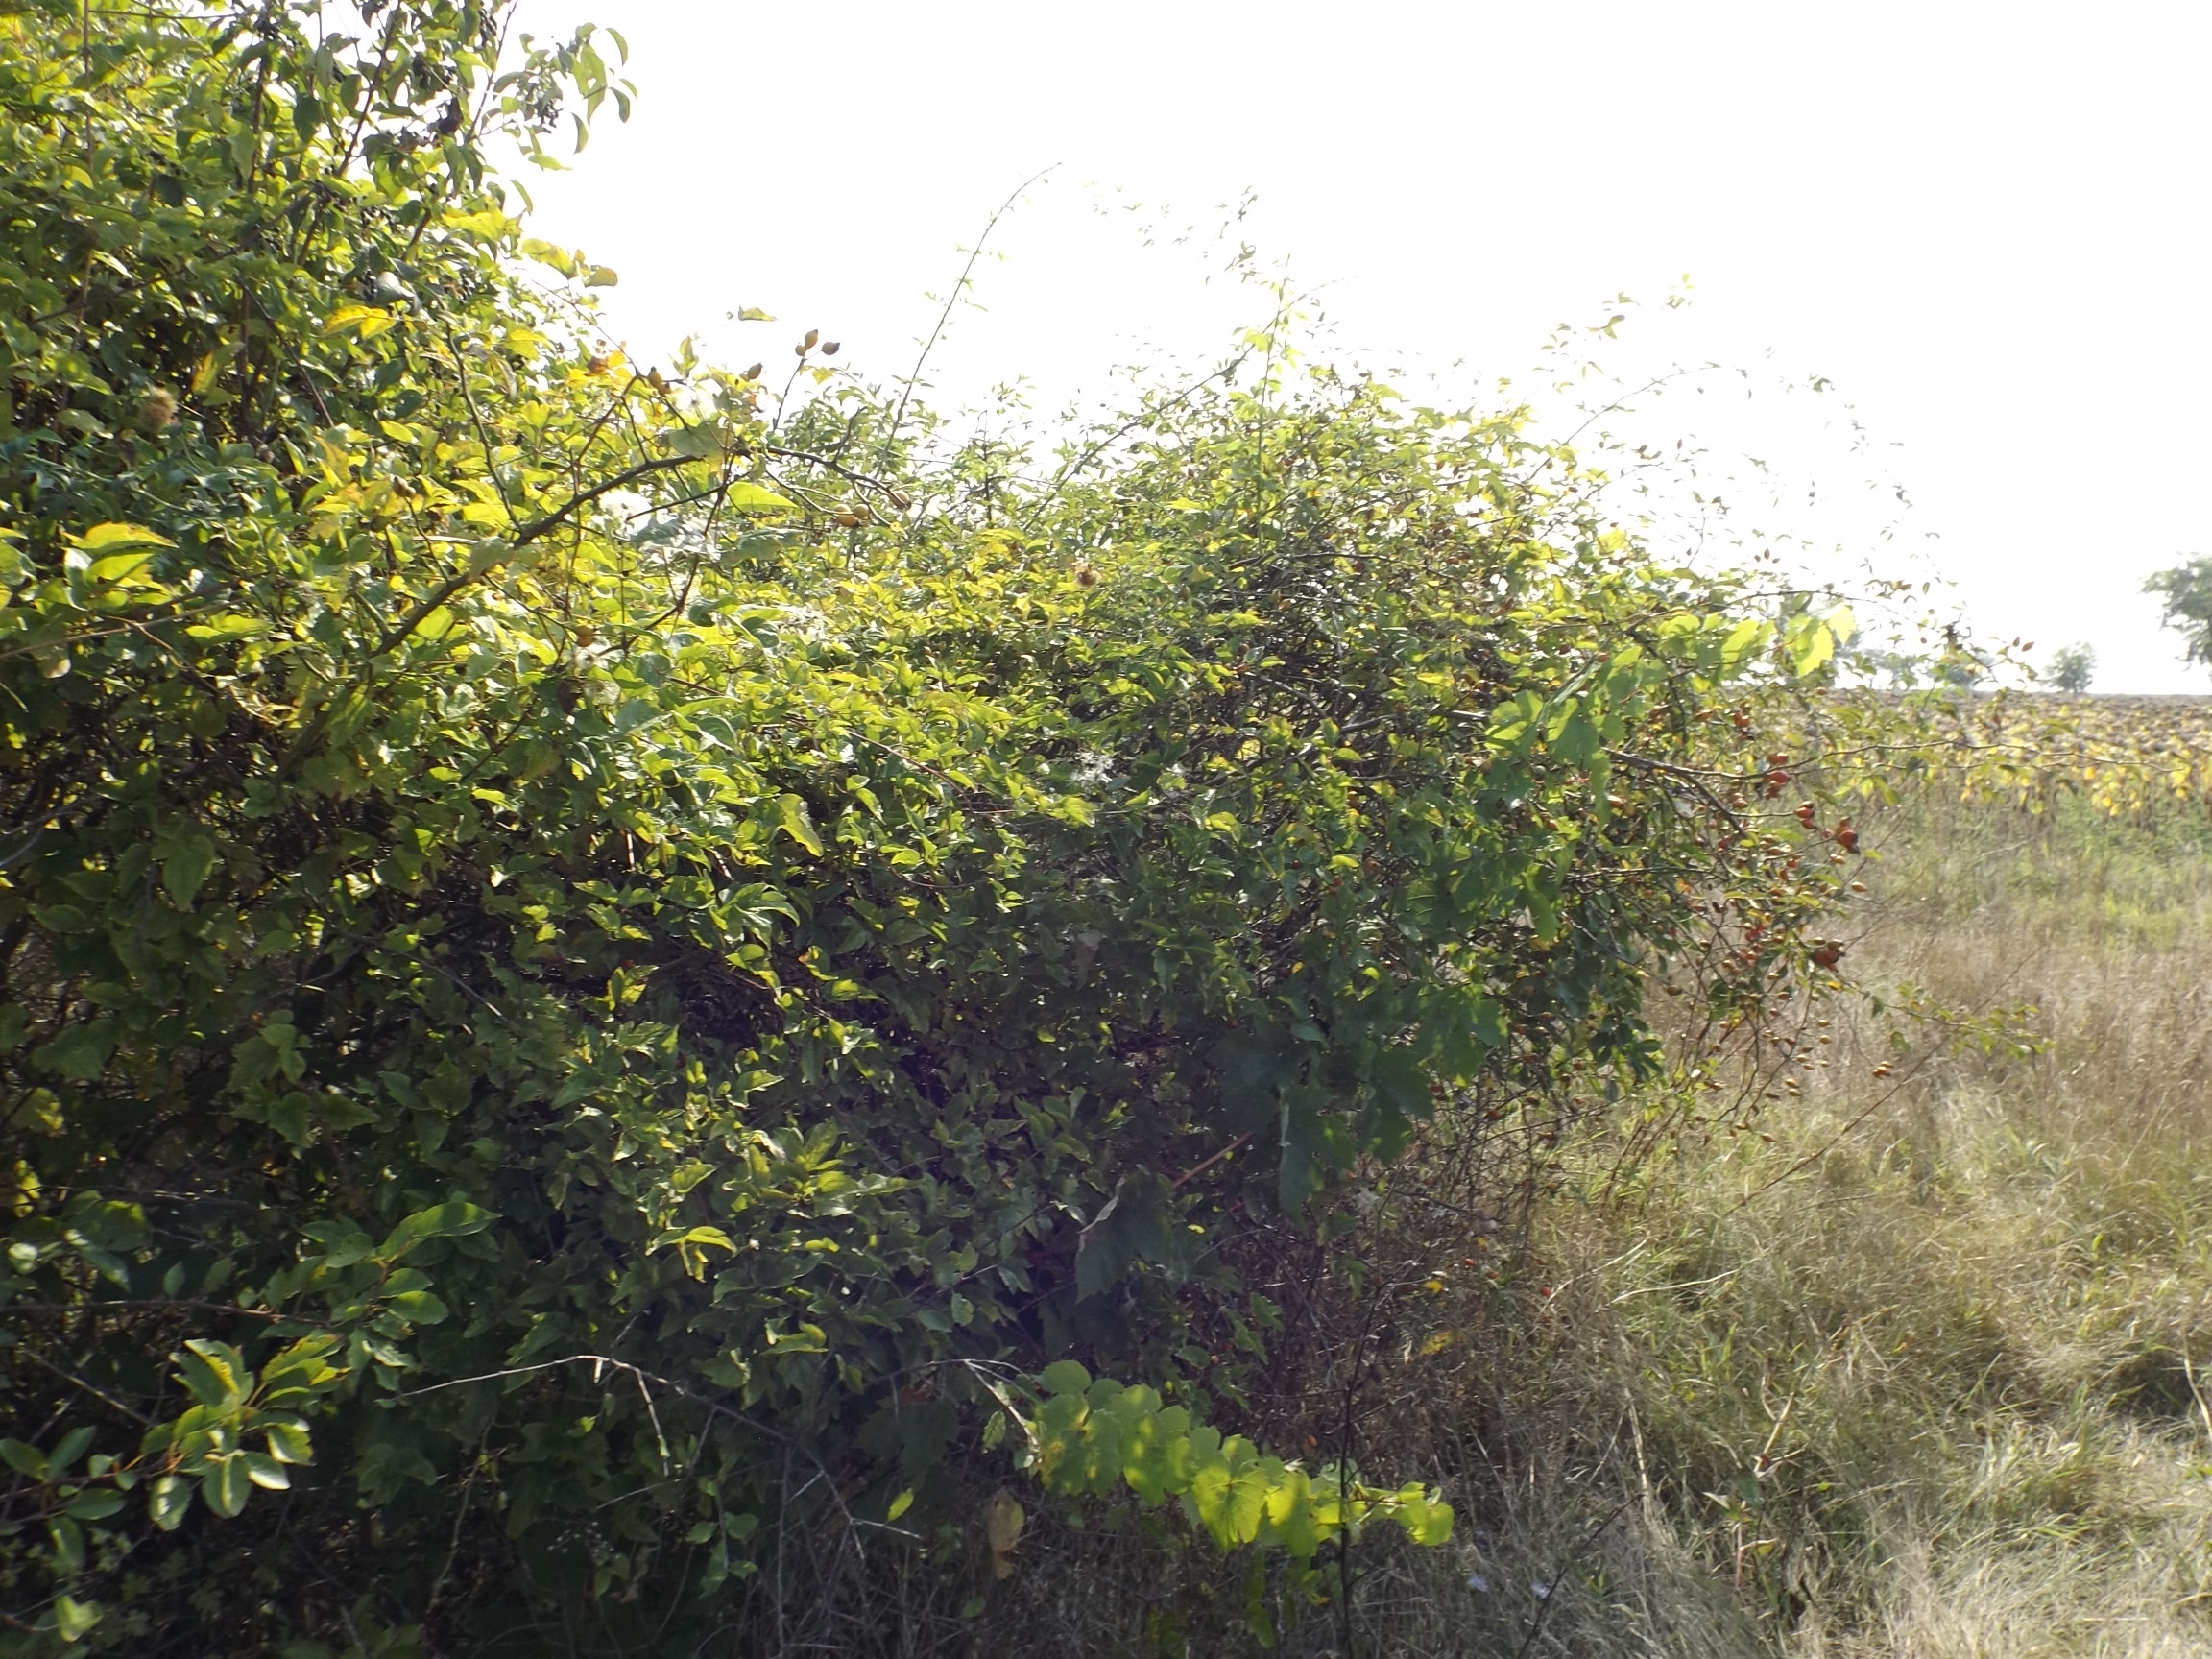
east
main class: Shrubland
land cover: Shrubland with sparse tree cover
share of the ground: > 75 %
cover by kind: shrubs 75 %, herbaceous plants 20 %, broadleaved forest trees 5 %
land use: Semi-natural and natural areas not in use
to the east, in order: Shrubland with sparse tree cover; Grassland without tree/shrub cover; Tracks; Sunflower
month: August
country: BG
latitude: 43.2164
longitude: 27.2942
